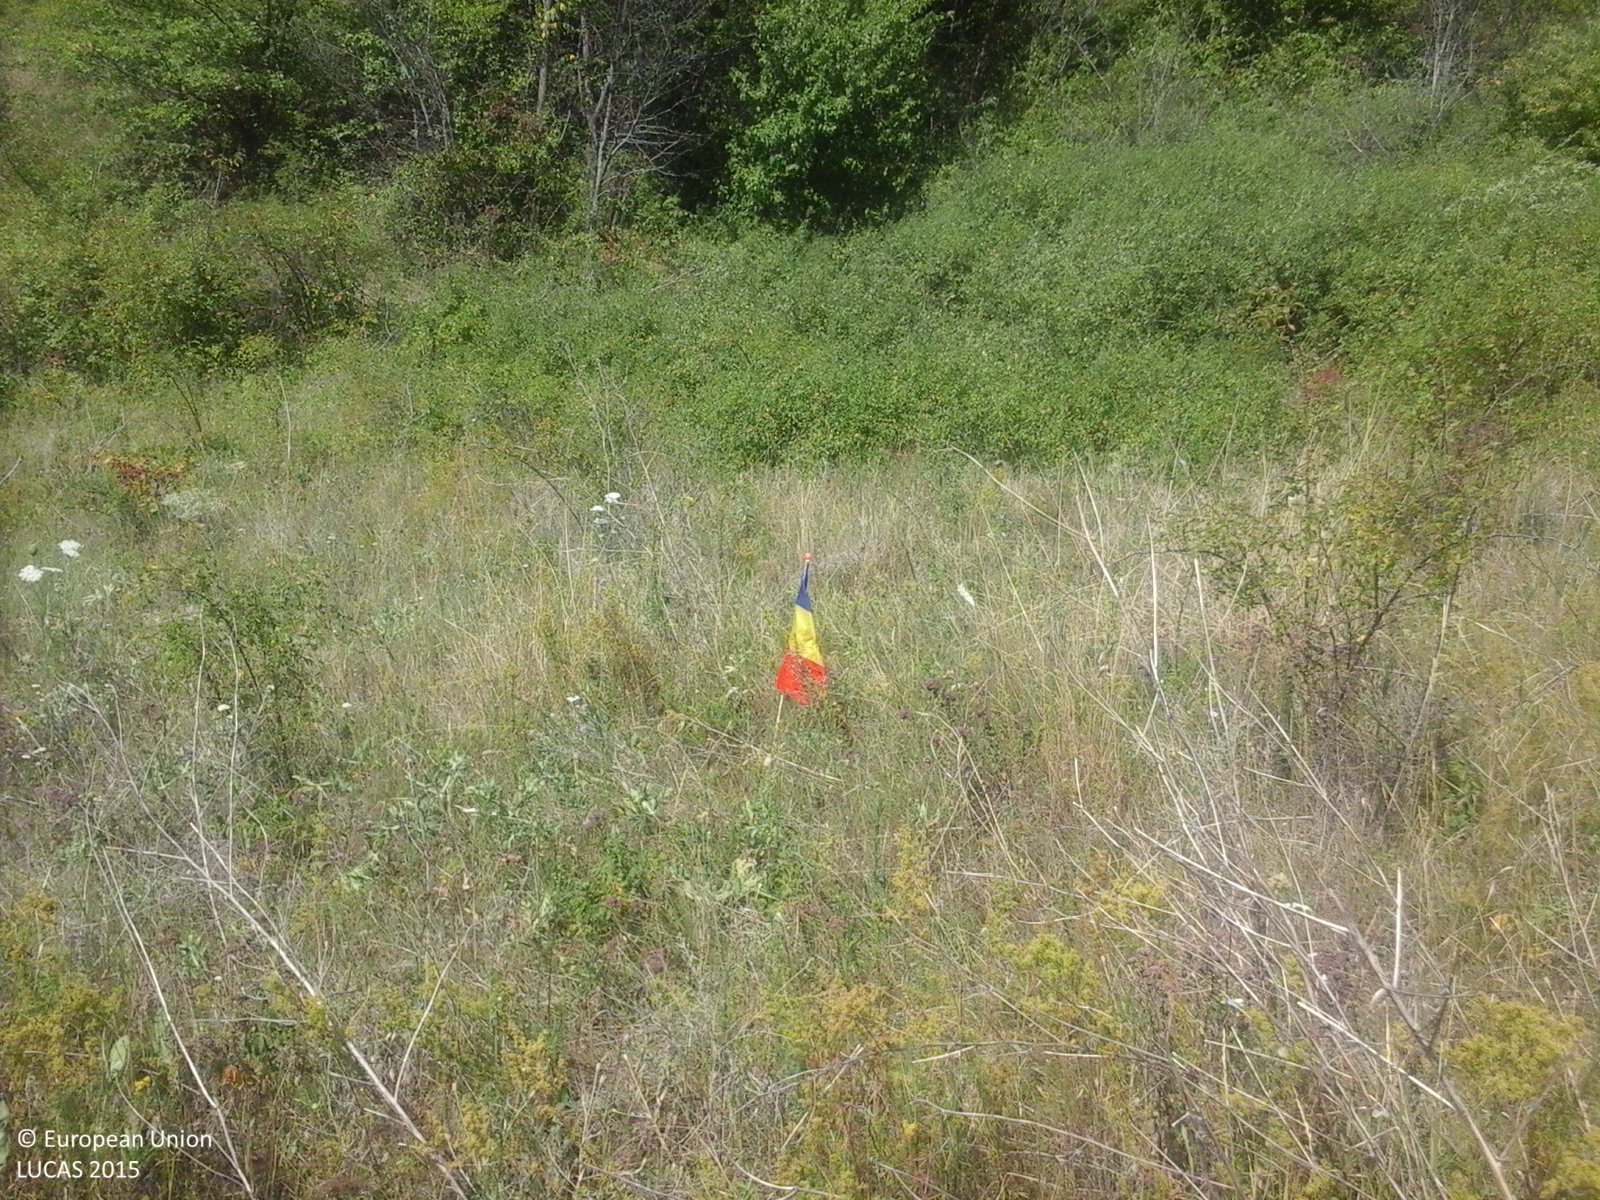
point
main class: Shrubland
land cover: Shrubland with sparse tree cover
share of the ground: > 75 %
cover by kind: shrubs 75 %, herbaceous plants 20 %, broadleaved forest trees 5 %
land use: Semi-natural and natural areas not in use
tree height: > 5 m
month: July
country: RO
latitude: 46.5412
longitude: 27.2244
